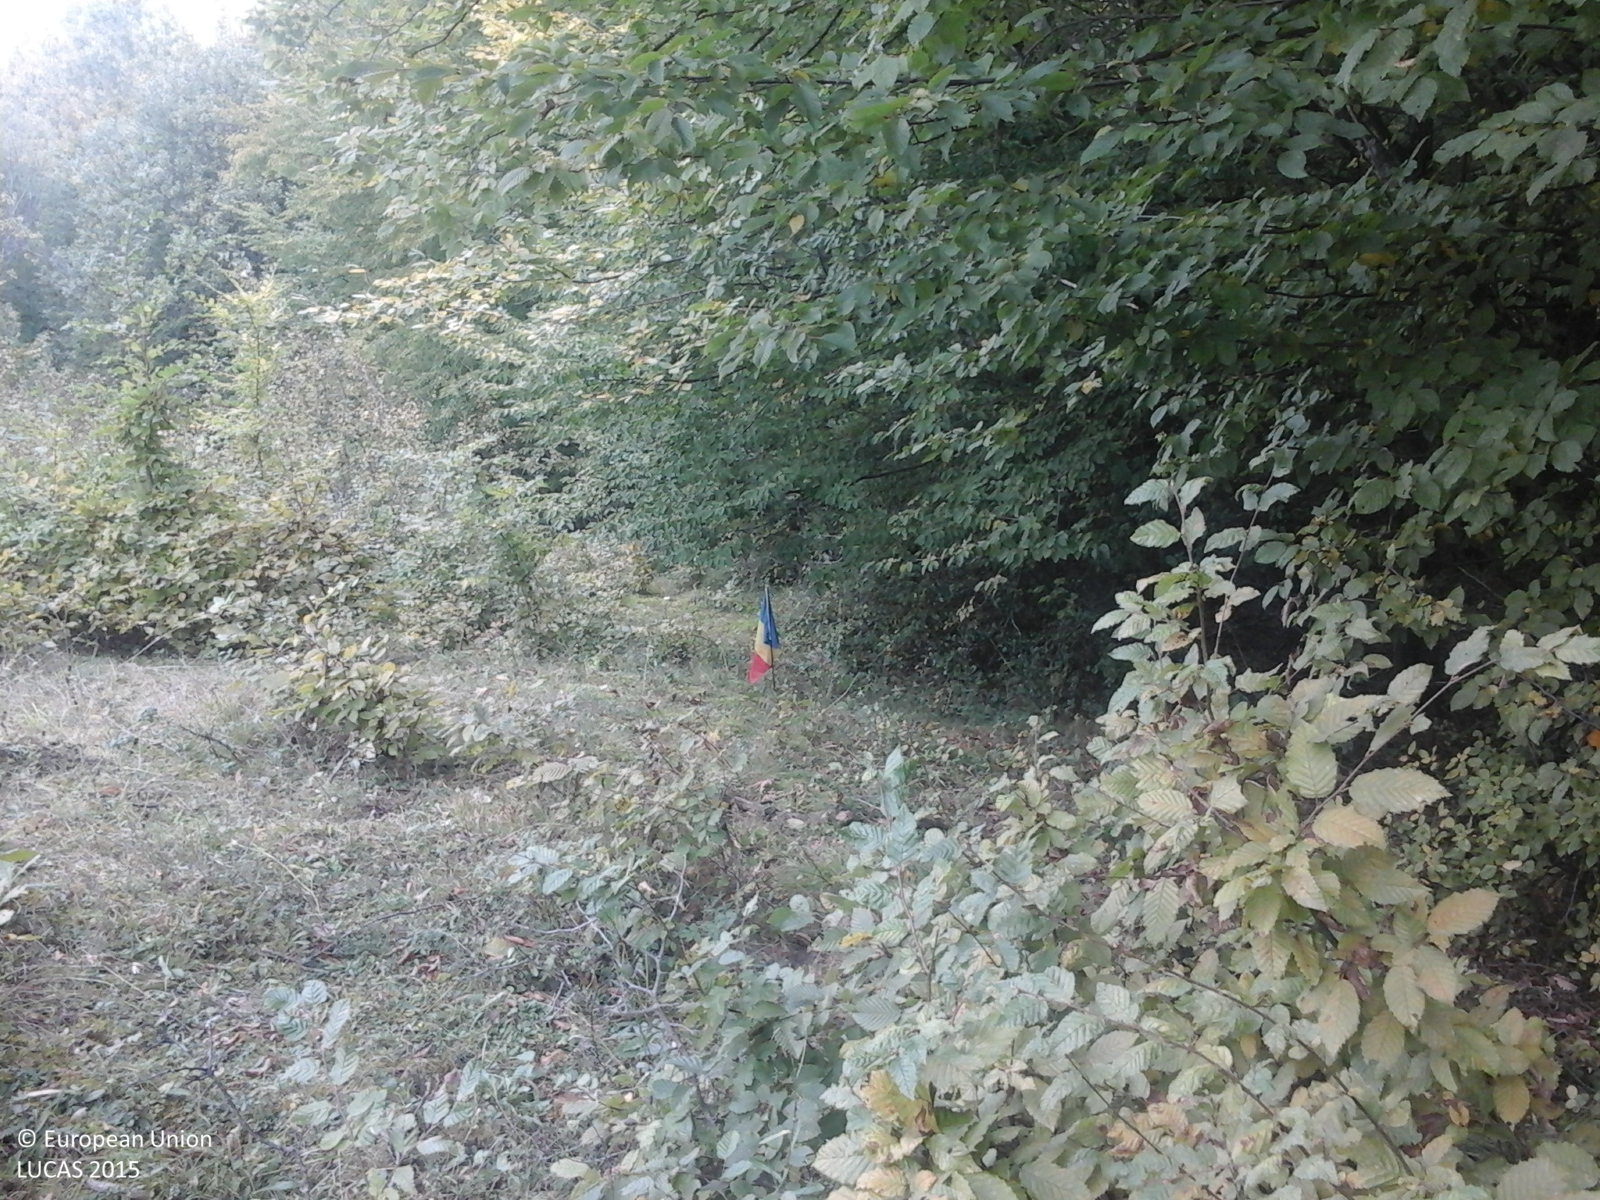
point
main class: Woodland
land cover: Broadleaved woodland
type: beech forest
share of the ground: > 75 %
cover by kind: broadleaved forest trees 100 %
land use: Forestry
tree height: > 5 m
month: October
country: RO
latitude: 45.9522
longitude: 25.2053
